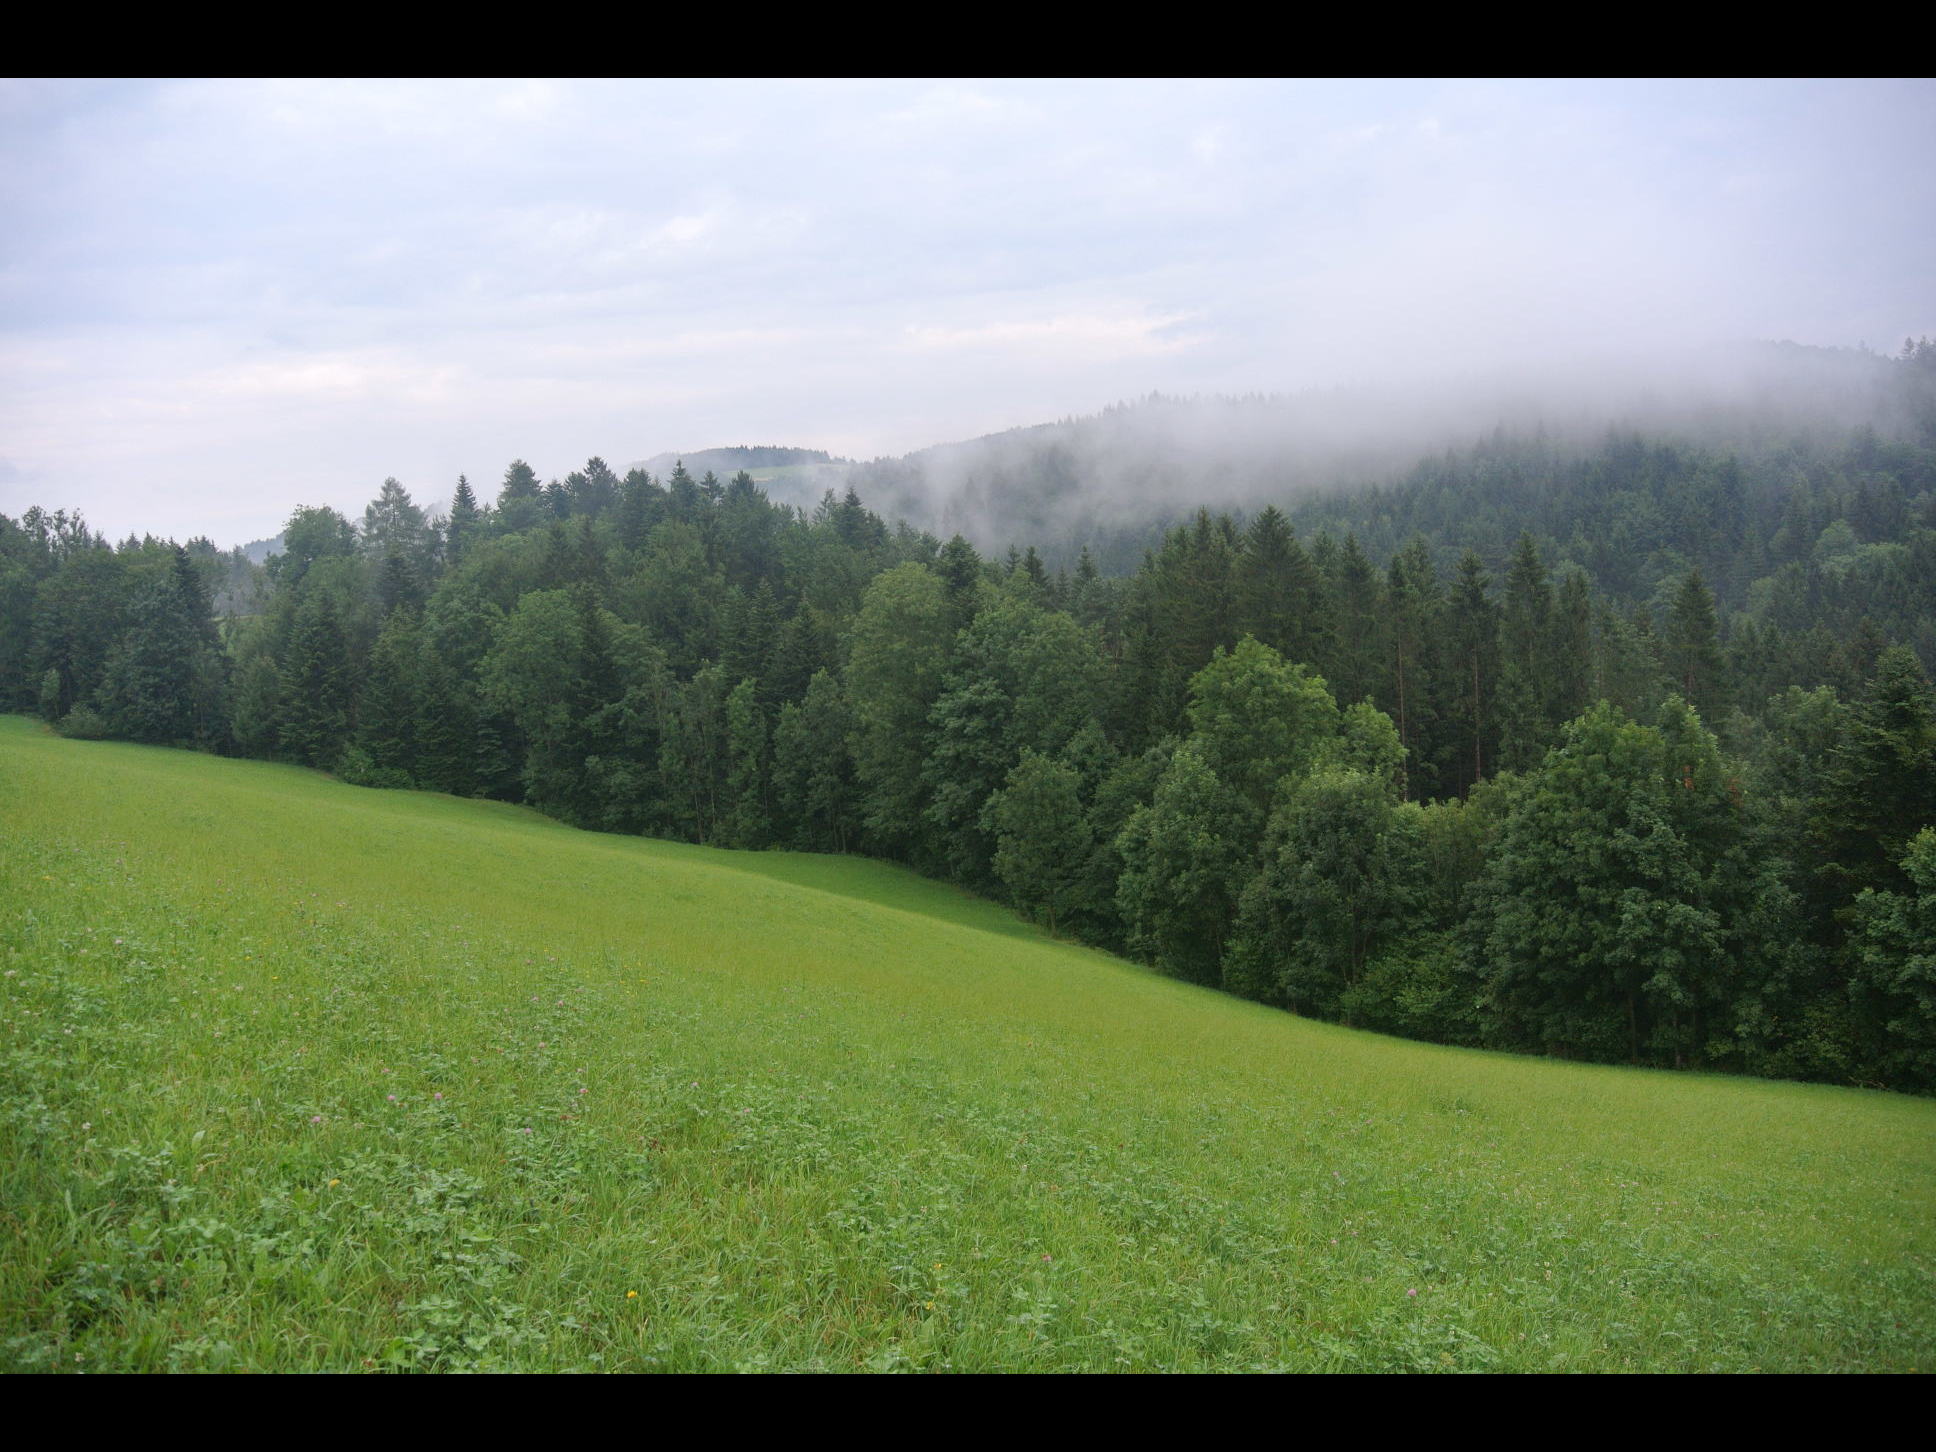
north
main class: Grassland
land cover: Grassland without tree/shrub cover
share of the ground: > 75 %
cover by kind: herbaceous plants 100 %
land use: Agriculture (excluding fallow land and kitchen gardens)
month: July
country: AT
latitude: 47.4730
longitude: 16.1725
